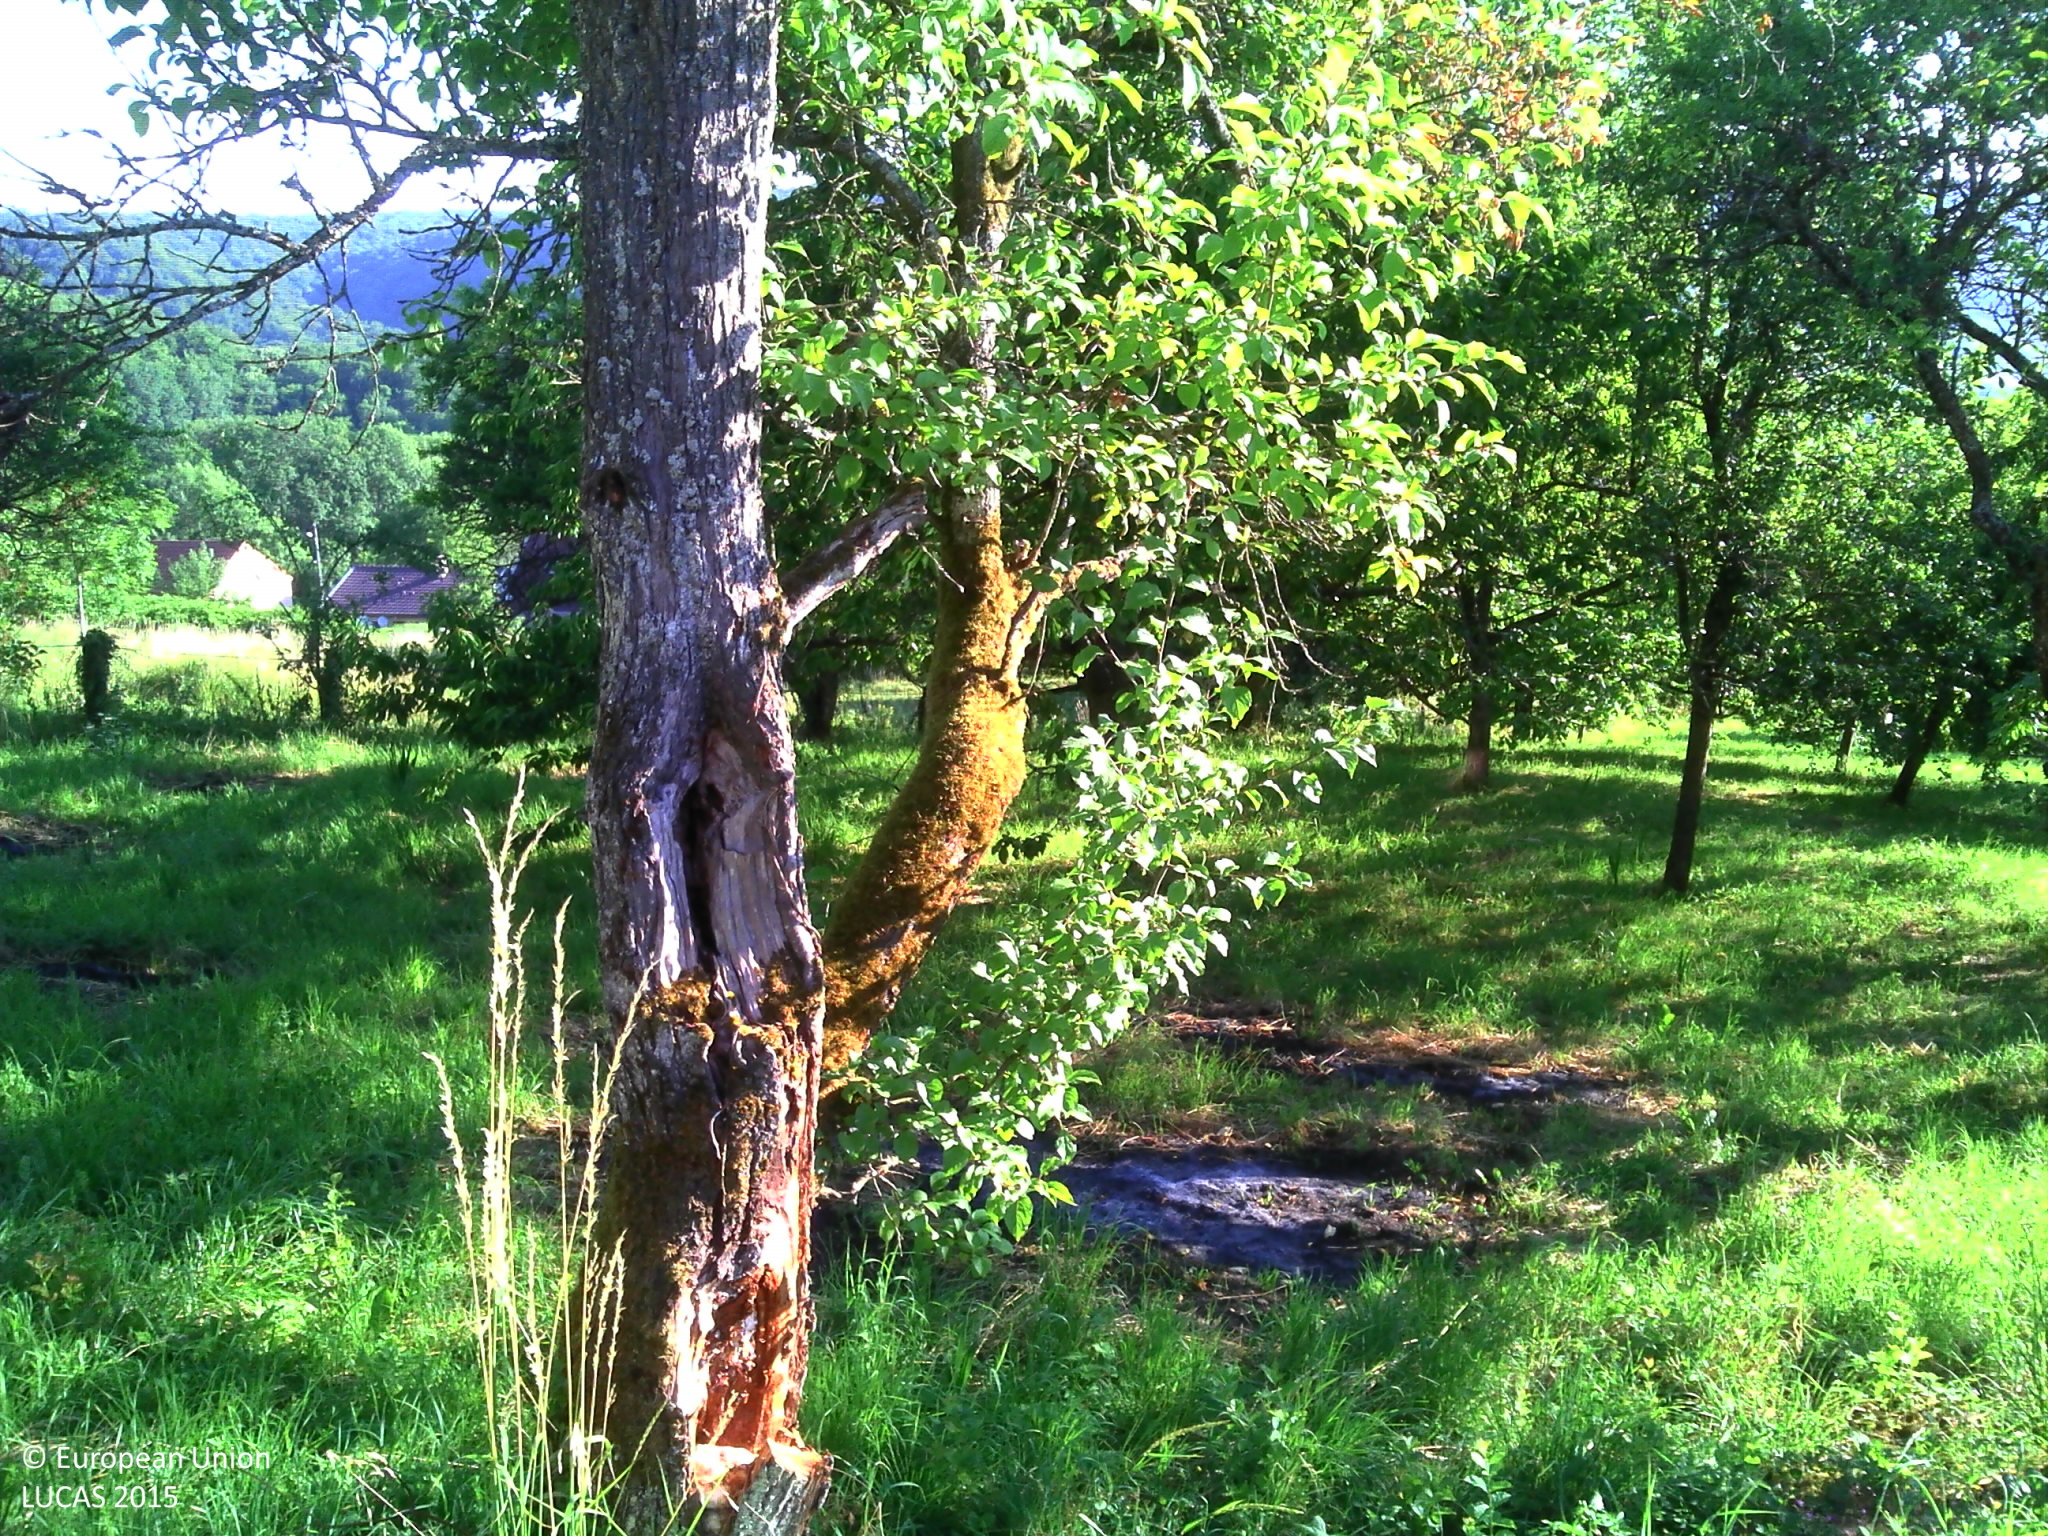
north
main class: Cropland
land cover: Cherry fruit
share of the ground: 50 - 75 %
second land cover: Other fruit trees and berries
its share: 50 - 75 %
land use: Kitchen garden
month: June
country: FR
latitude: 48.9795
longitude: 5.9963
